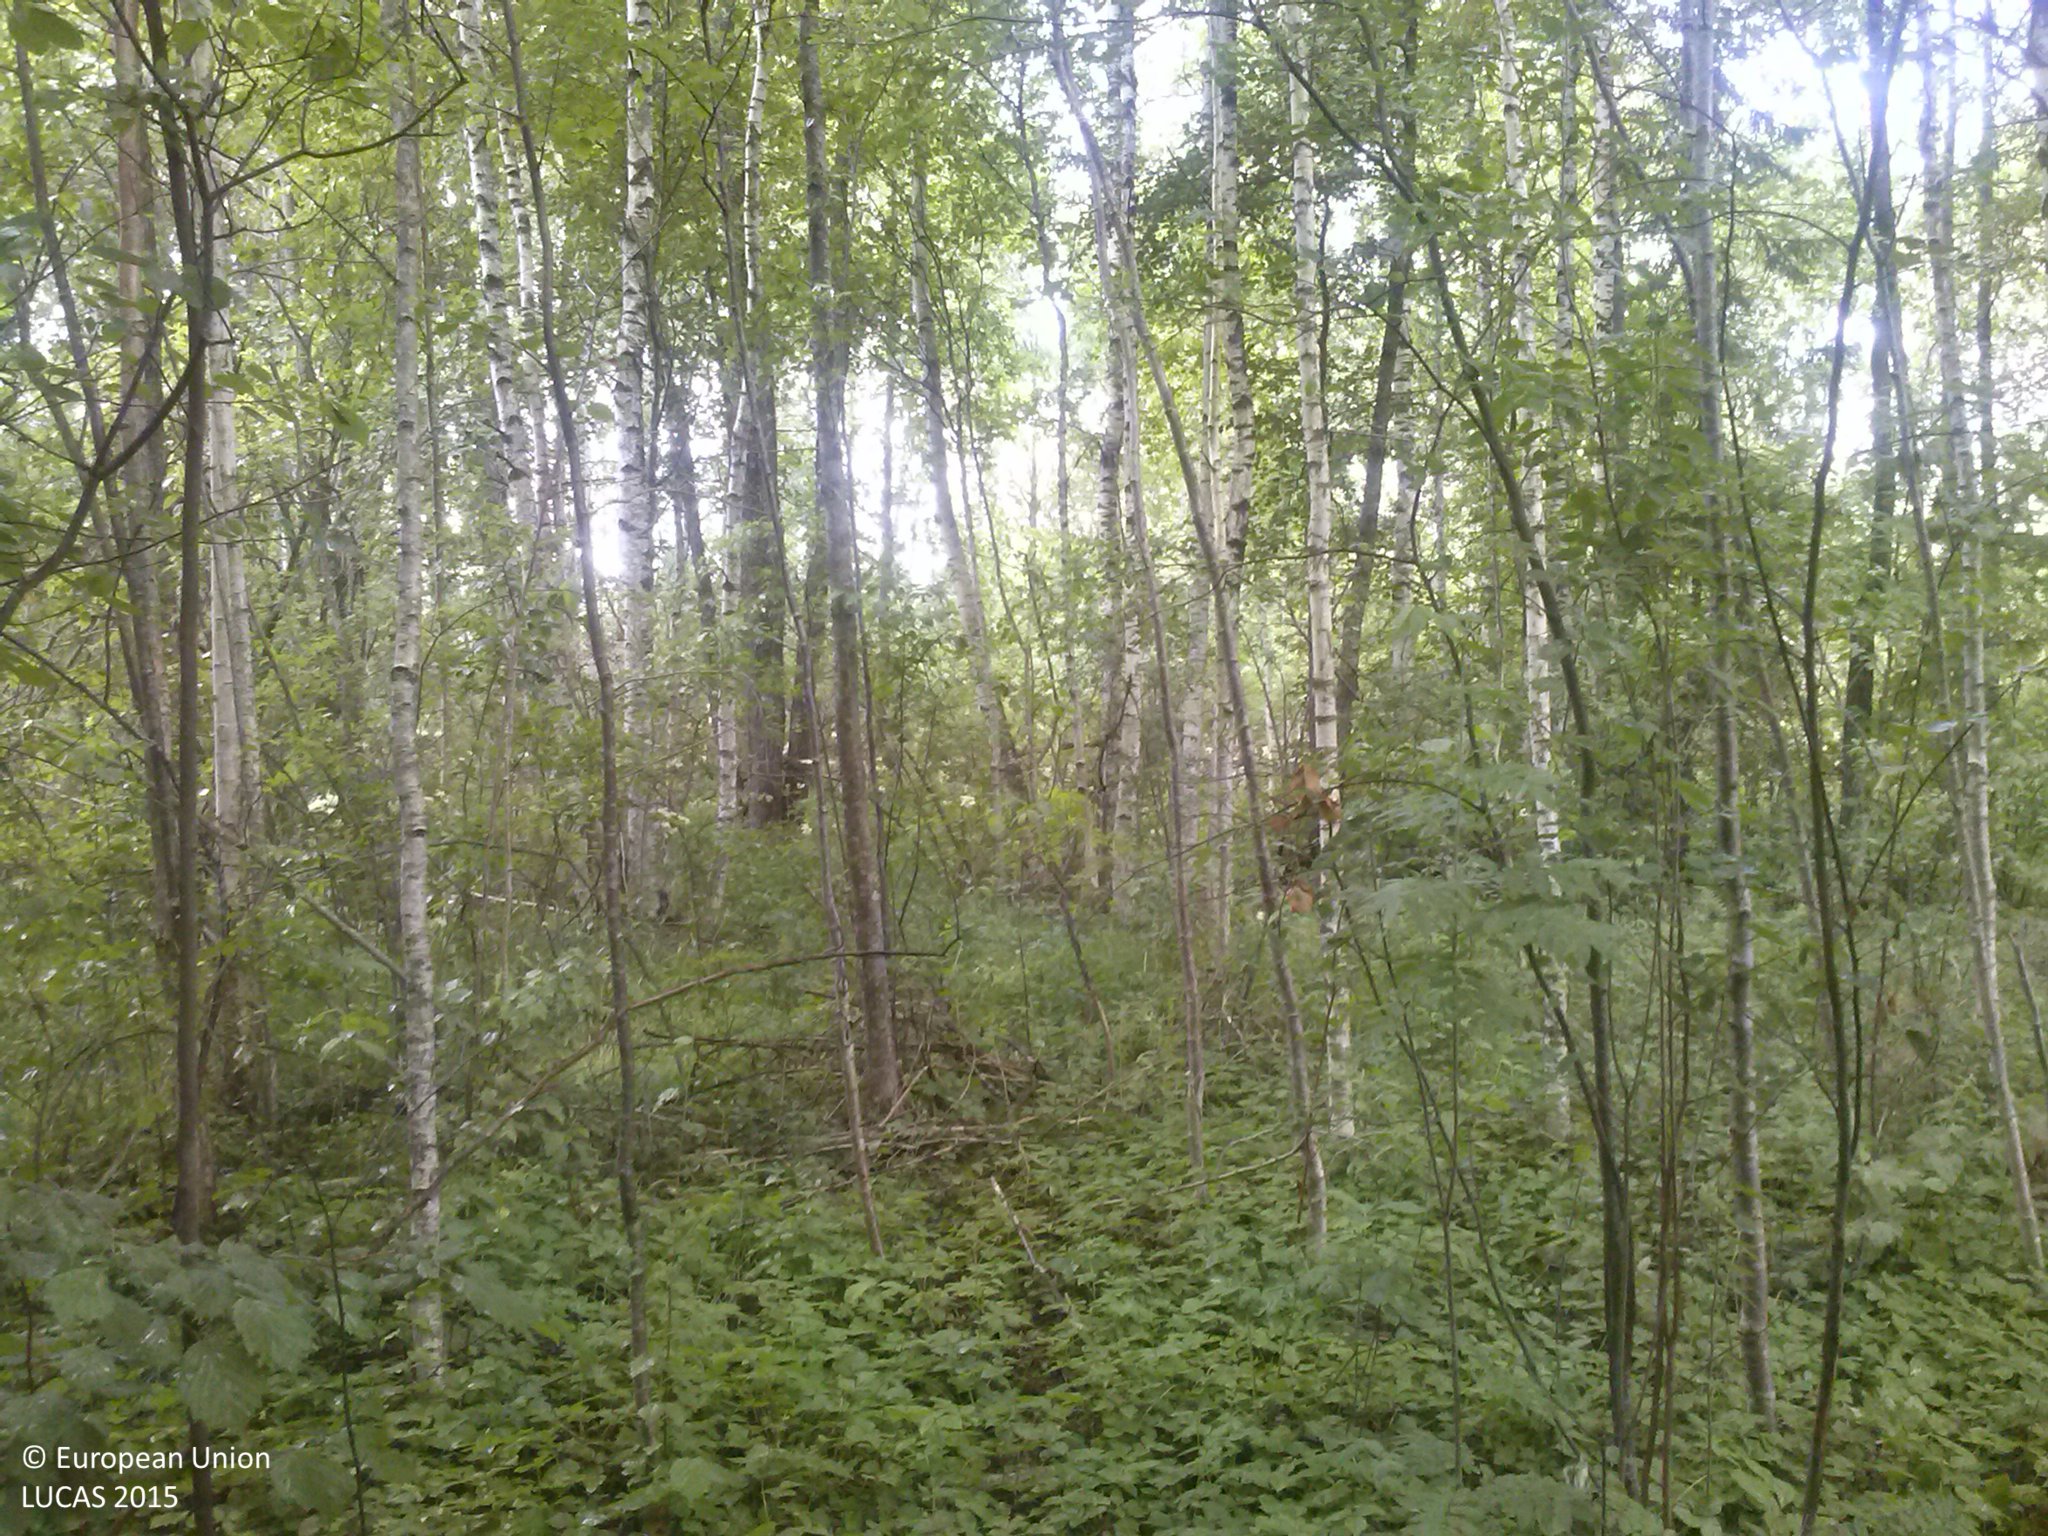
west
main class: Woodland
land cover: Broadleaved woodland
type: non-riverine alder, birch or aspen forest
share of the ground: > 75 %
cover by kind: broadleaved forest trees 75 %, herbaceous plants 25 %
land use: Forestry
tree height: > 5 m
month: July
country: LV
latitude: 56.6959
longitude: 27.5718
